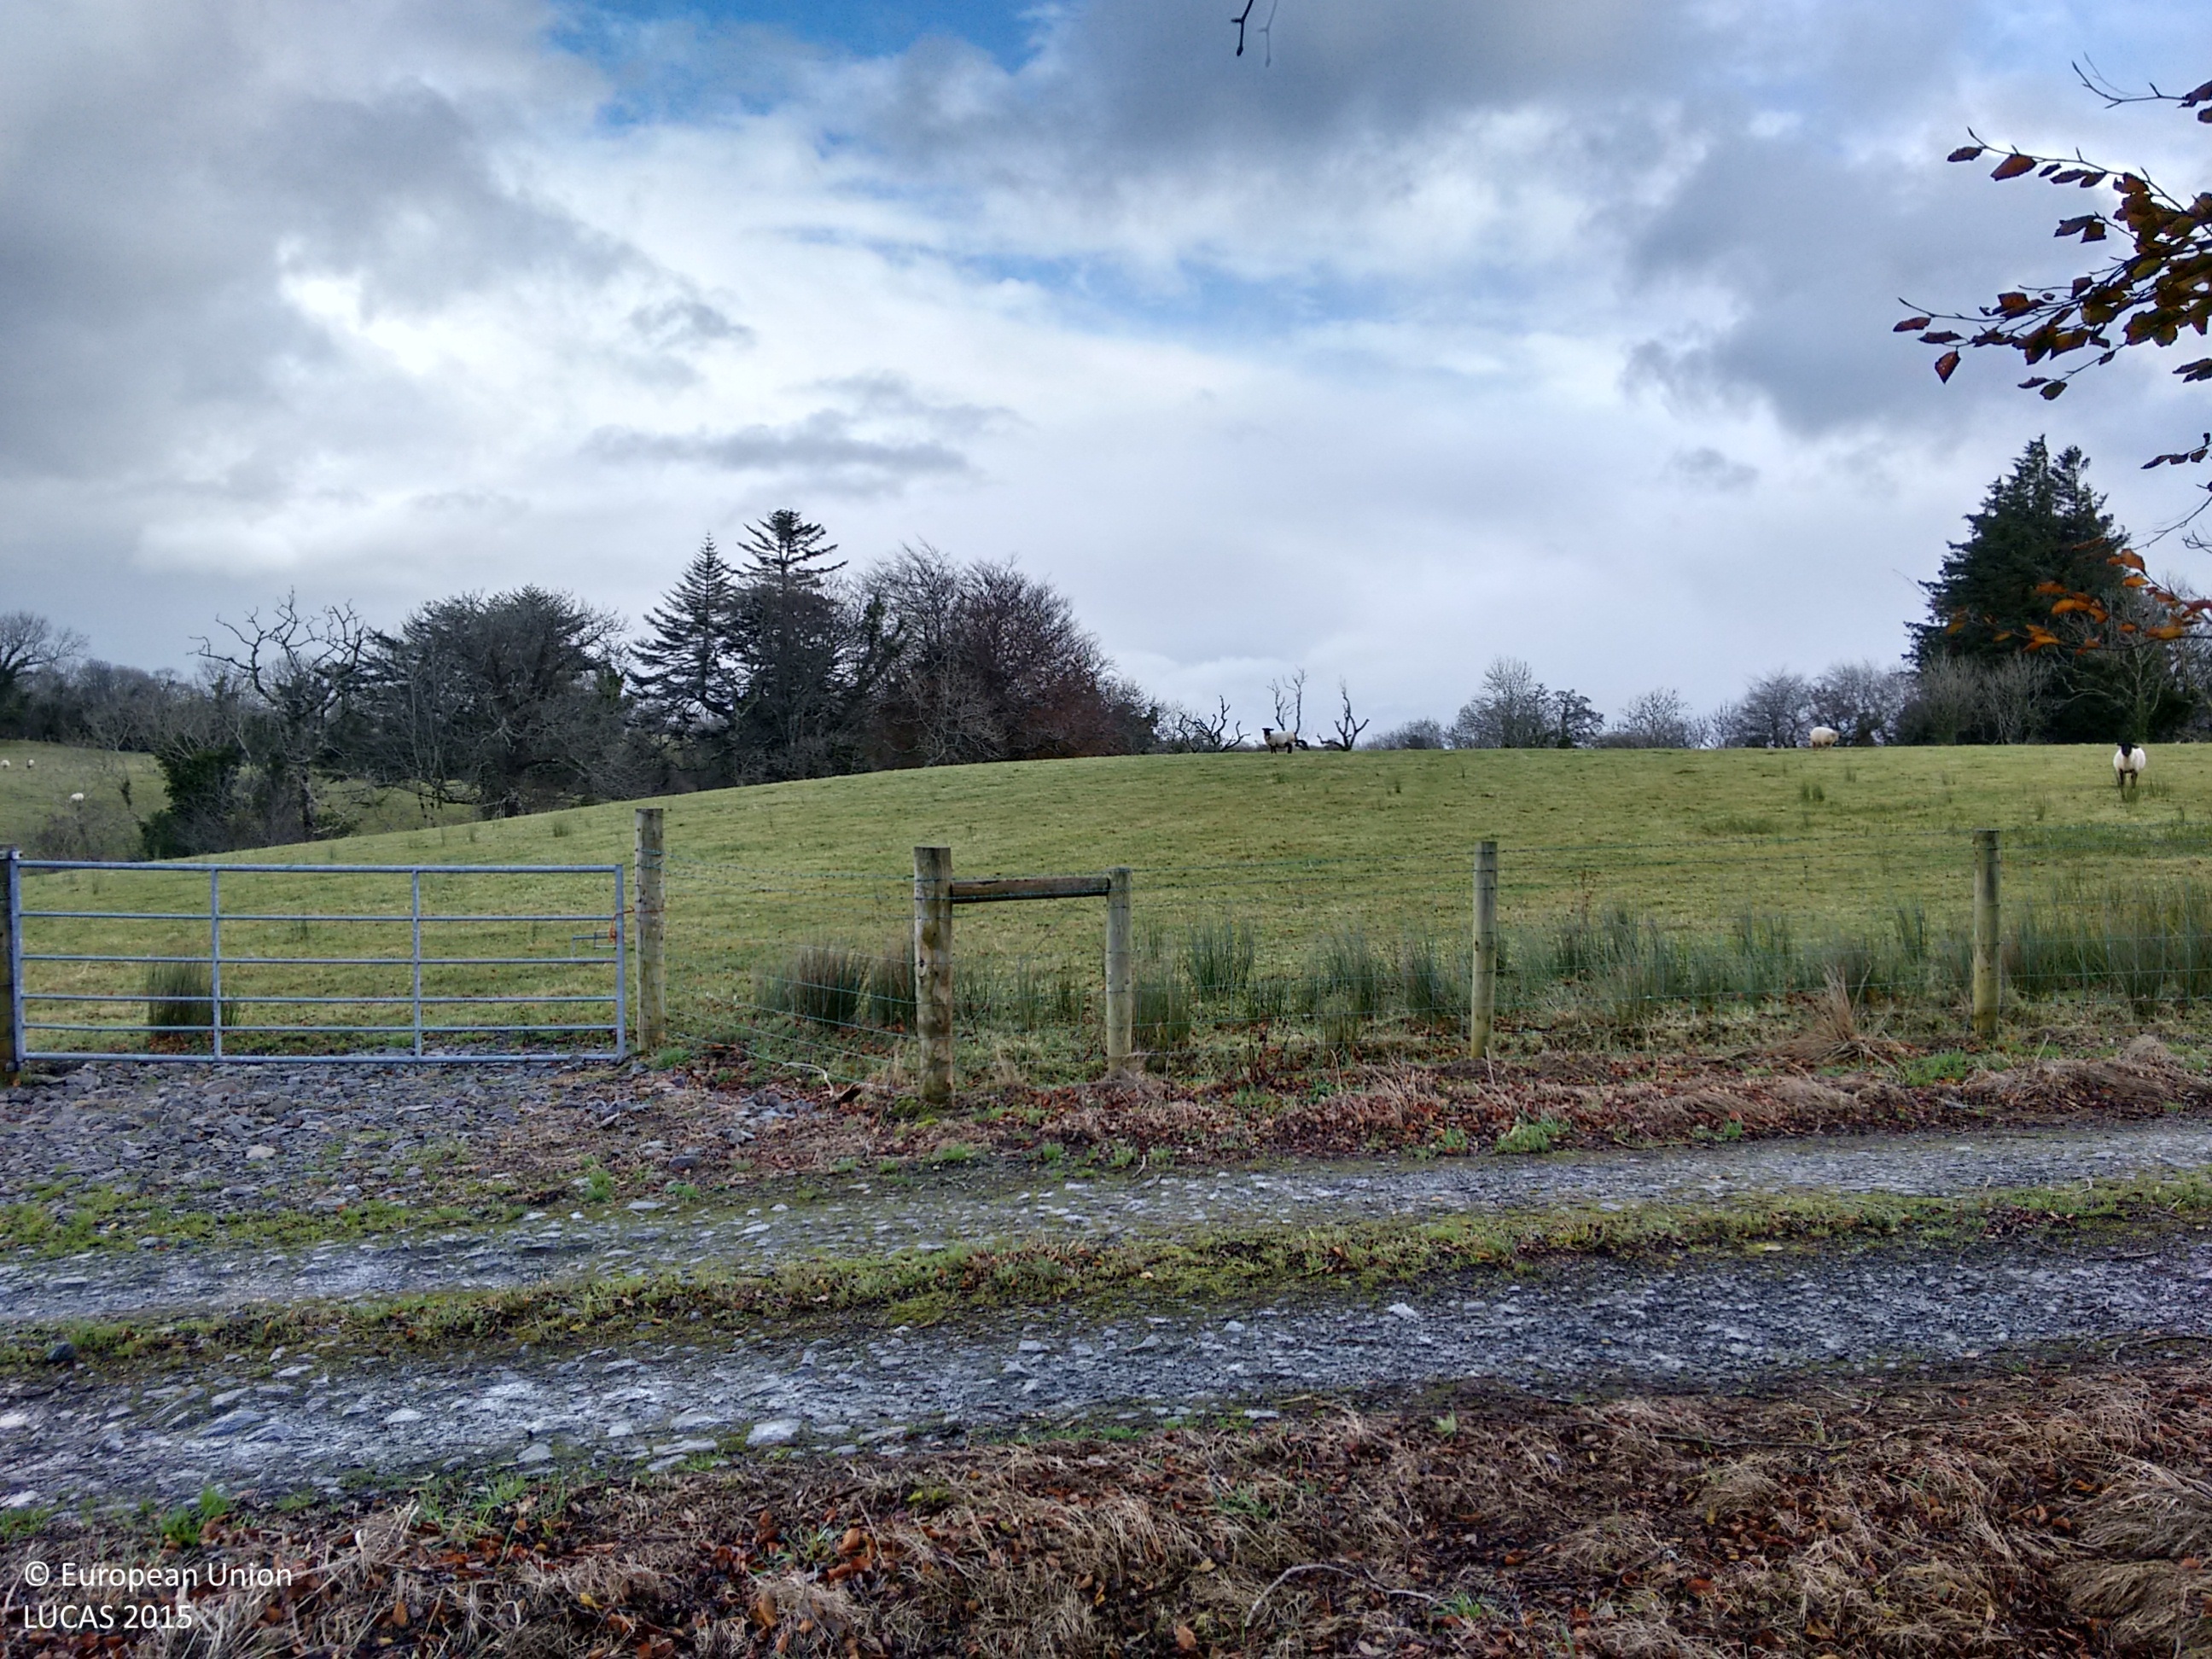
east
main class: Grassland
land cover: Grassland without tree/shrub cover
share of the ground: > 75 %
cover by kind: herbaceous plants 100 %
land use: Agriculture (excluding fallow land and kitchen gardens)
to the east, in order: Grassland without tree/shrub cover; Fences; Ditches and canals; Electric lines; Lines of trees; Grassland without tree/shrub cover; Fences; Other coniferous woodland; Artificial constructions in urban areas; Other coniferous woodland; Grassland without tree/shrub cover
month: November
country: IE
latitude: 54.4289
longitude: -8.2960
